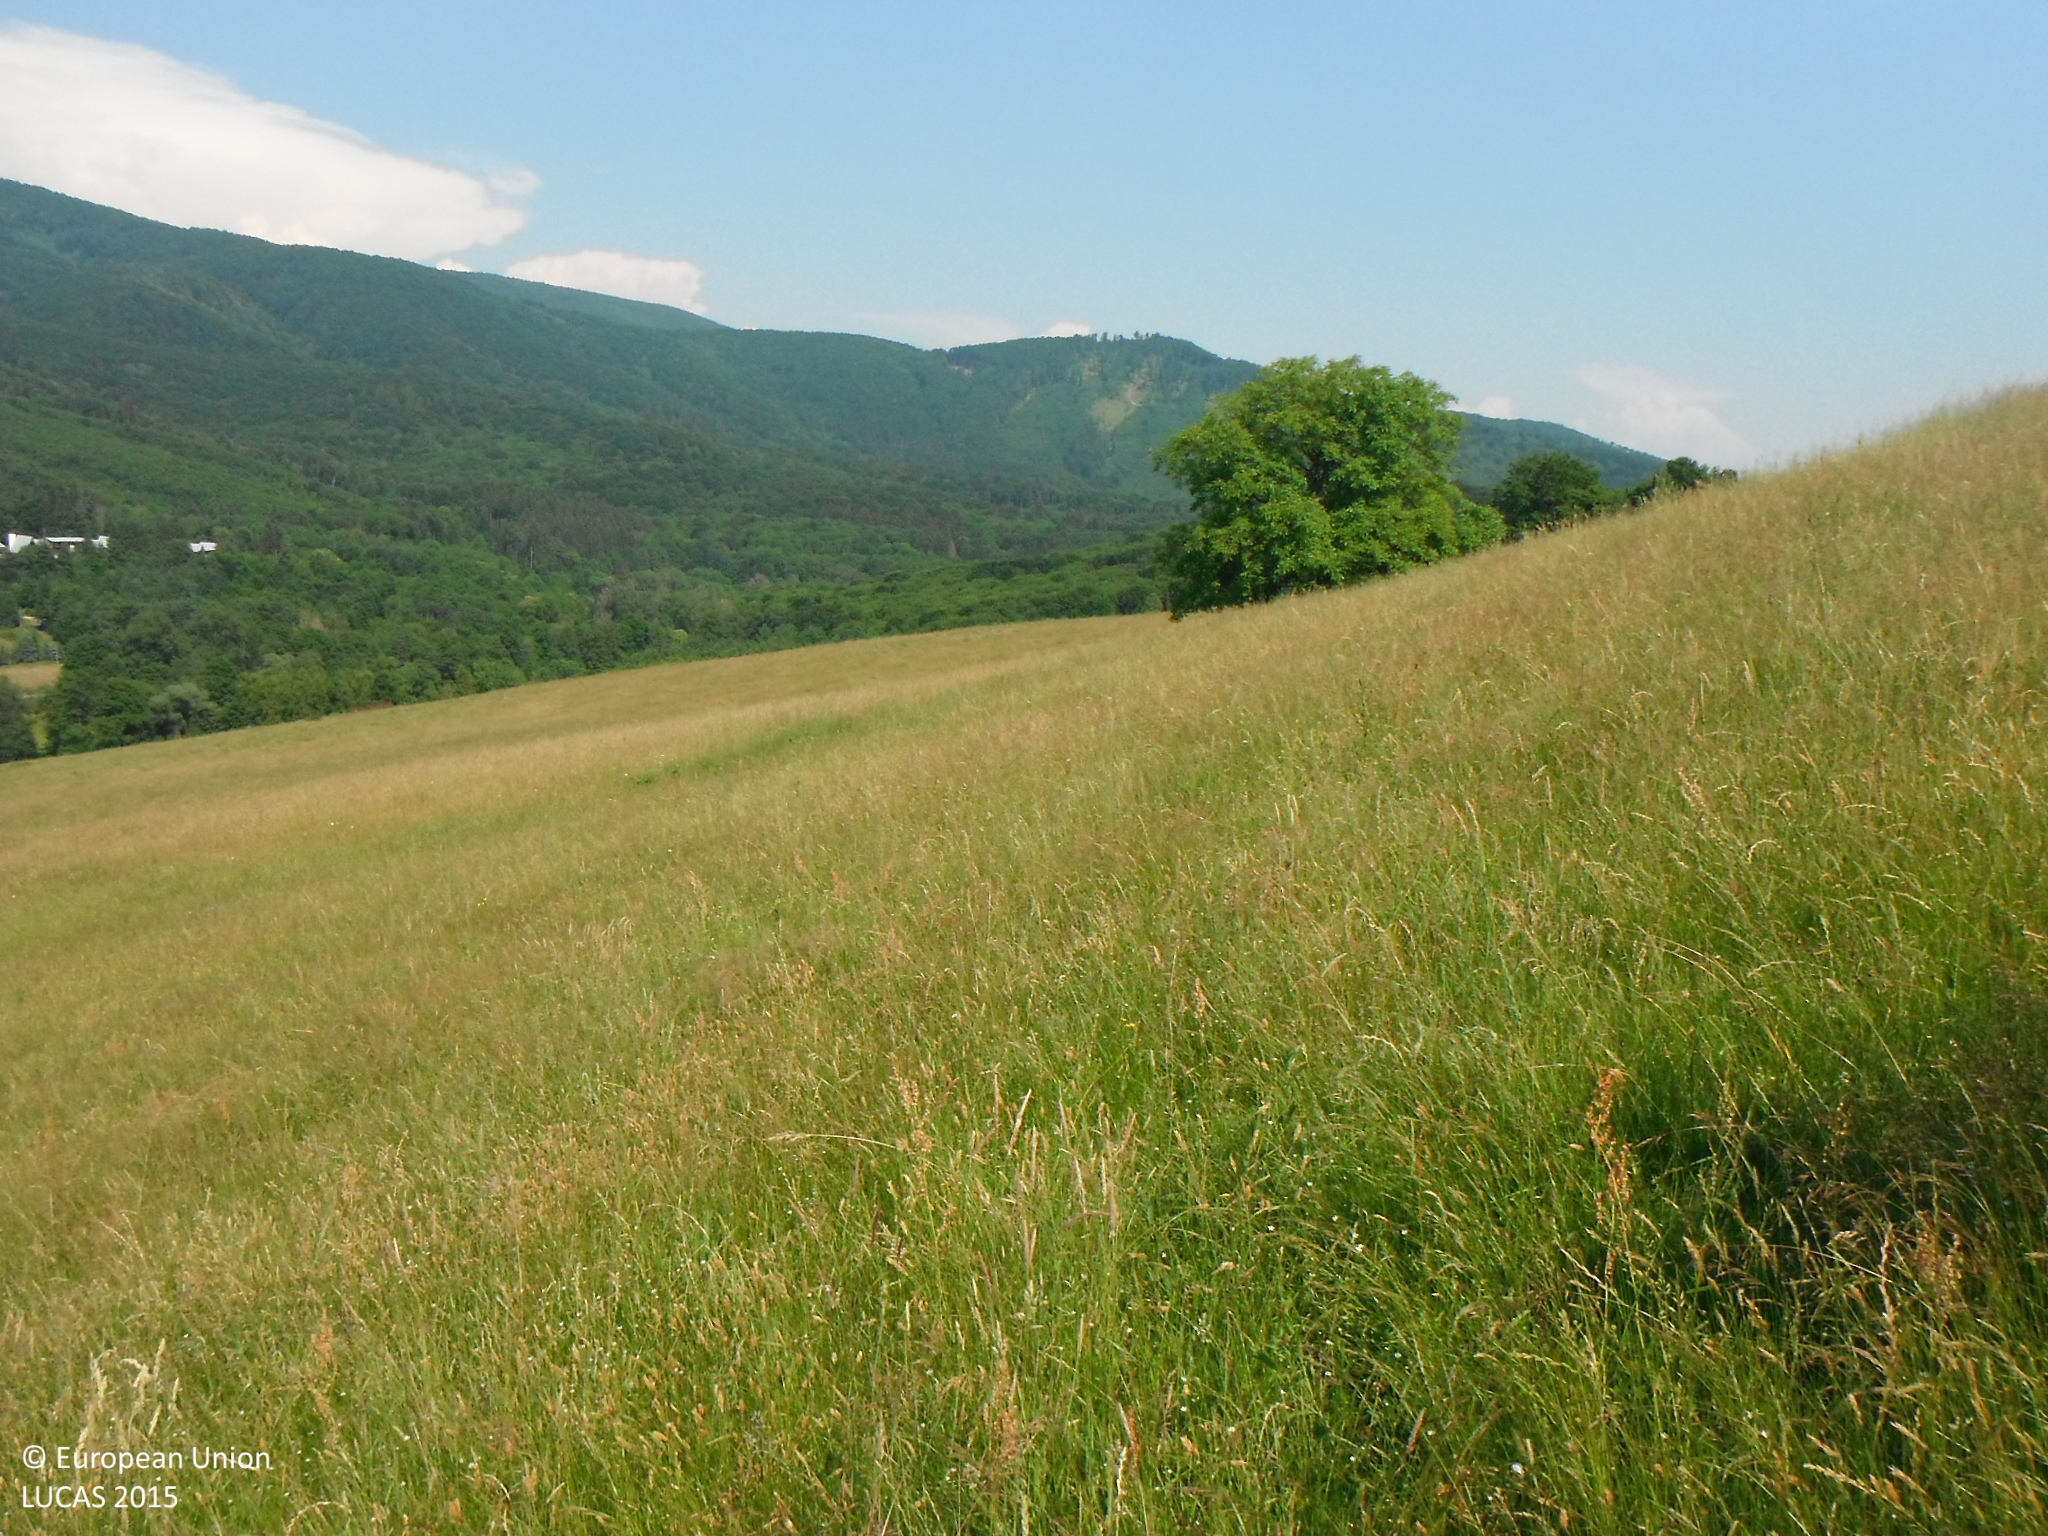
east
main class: Grassland
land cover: Grassland without tree/shrub cover
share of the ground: > 75 %
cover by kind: herbaceous plants 100 %
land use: Agriculture (excluding fallow land and kitchen gardens)
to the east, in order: Grassland without tree/shrub cover
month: June
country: SK
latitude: 48.5428
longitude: 19.8484
